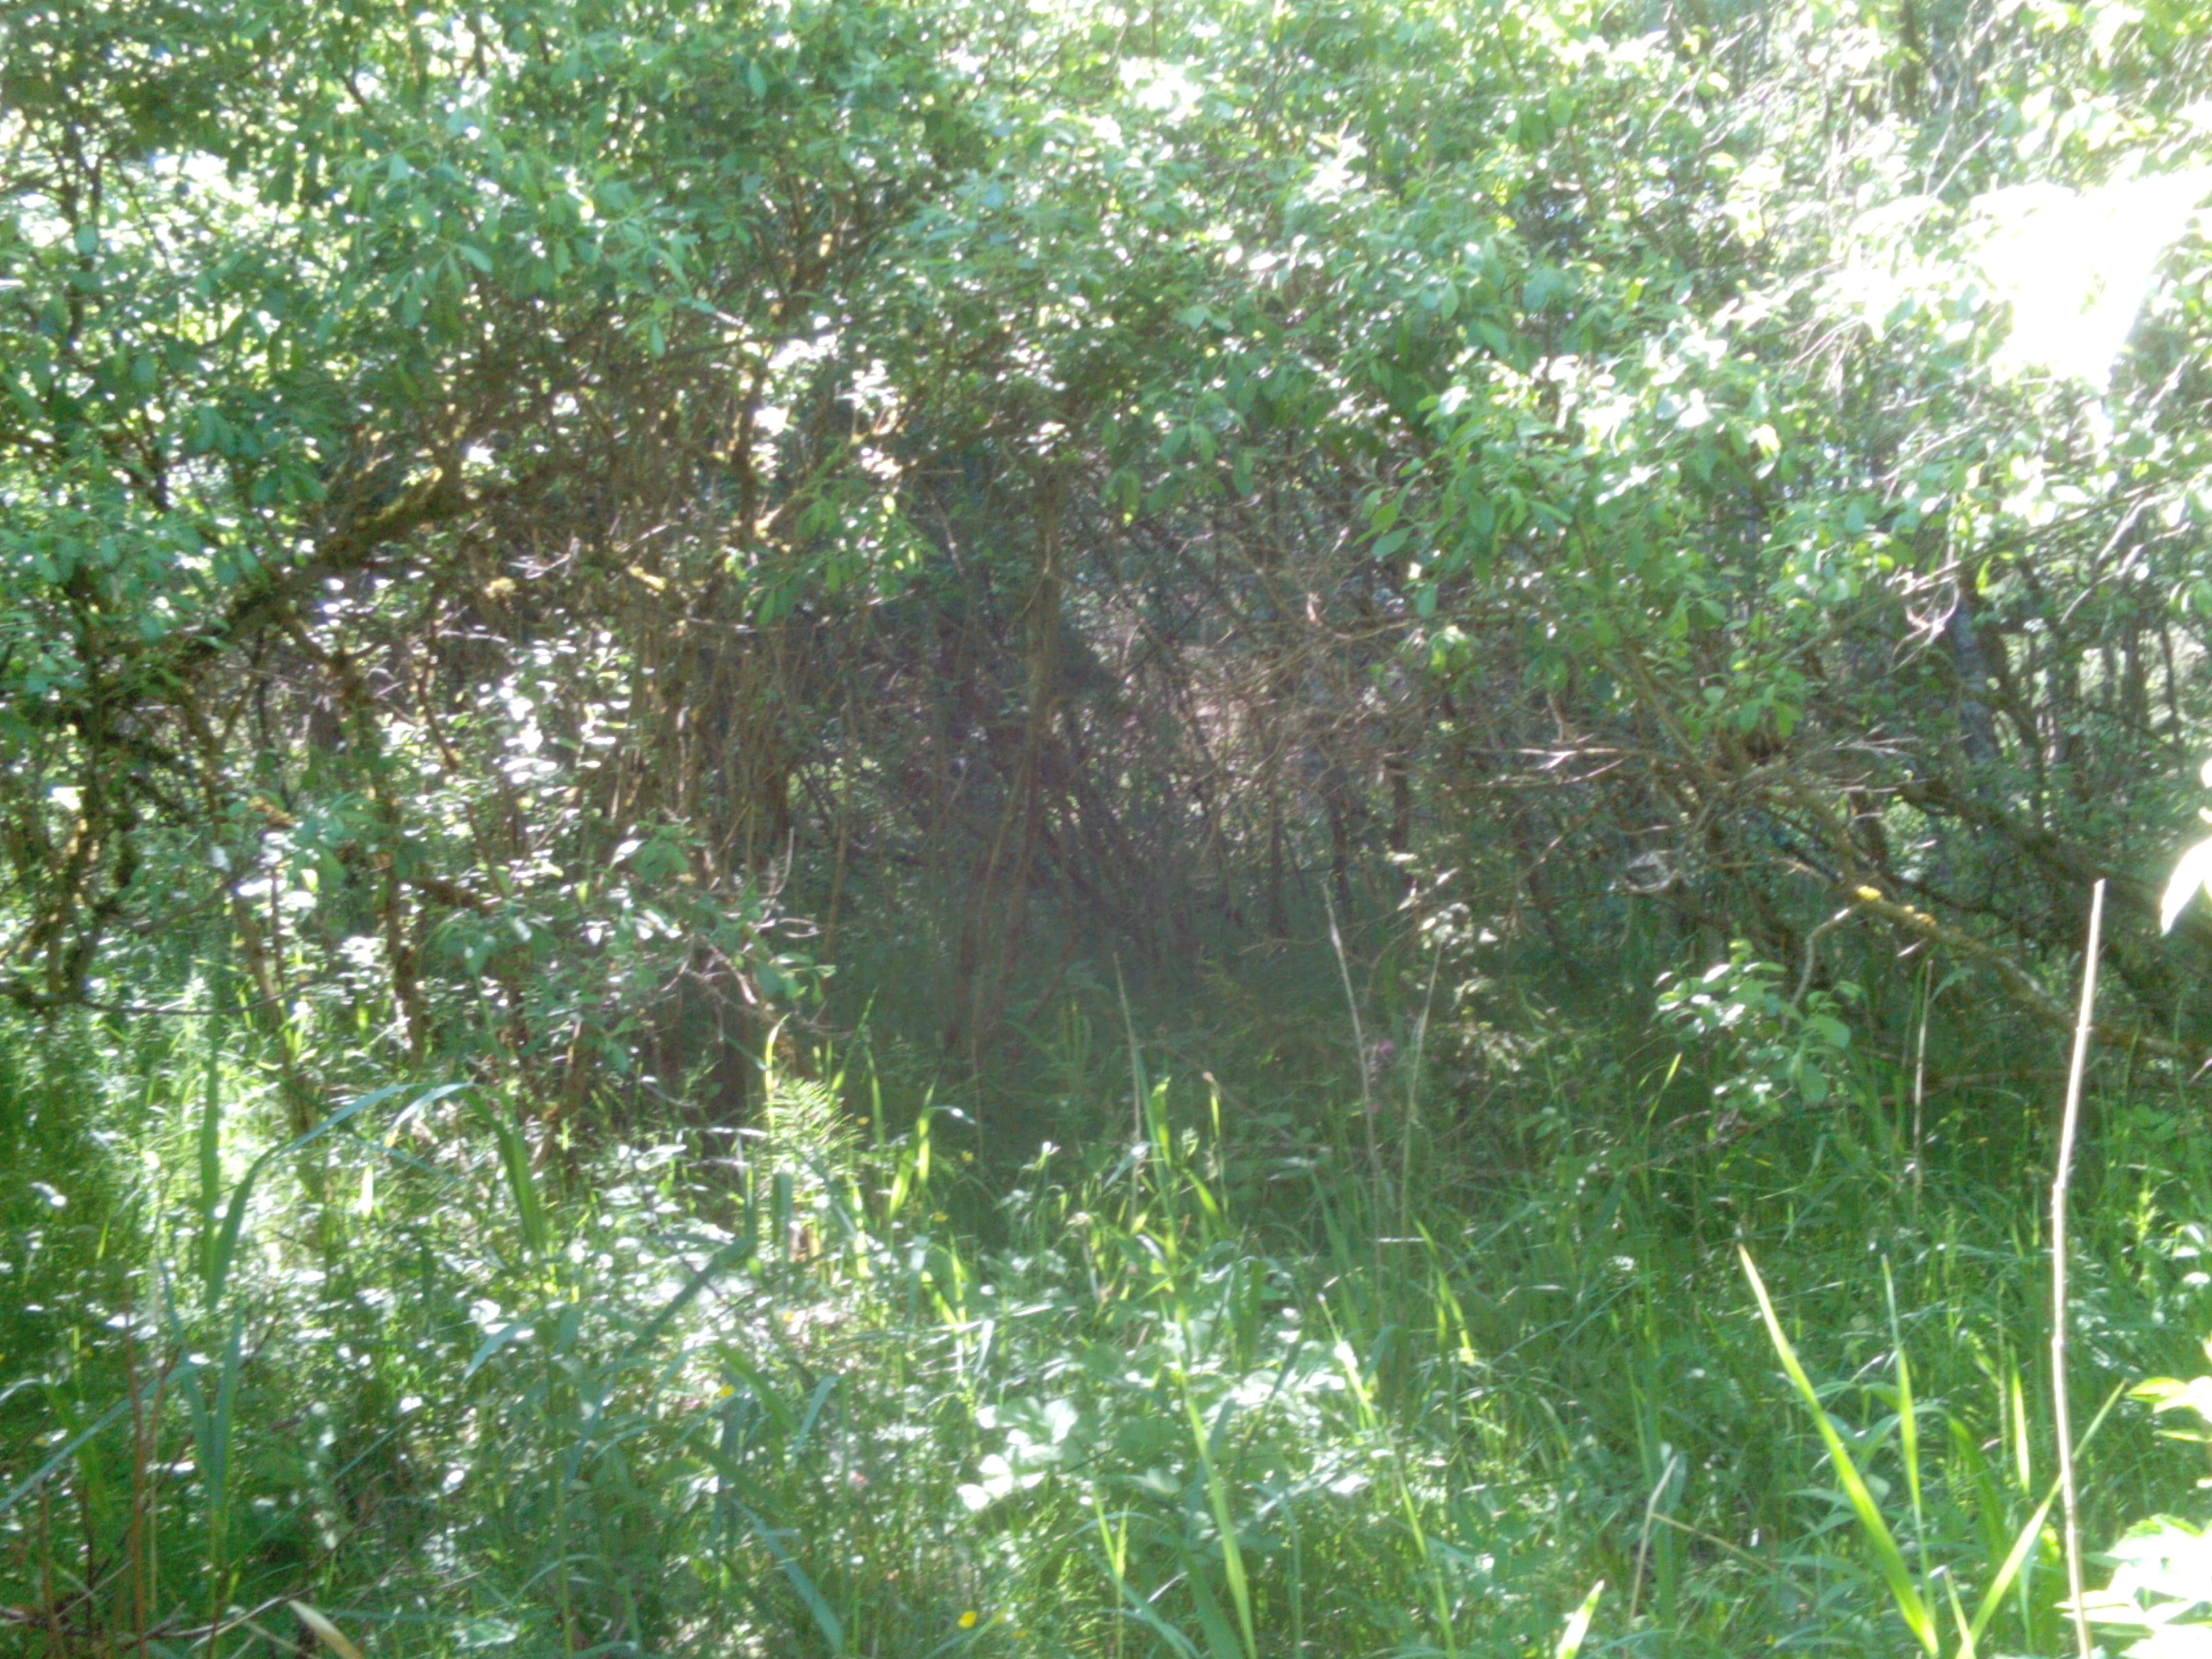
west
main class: Woodland
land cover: Spruce dominated mixed woodland
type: hemiboreal forest and nemoral coniferous forest and mixed broadleaved-coniferous forest
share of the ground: > 75 %
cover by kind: broadleaved forest trees 55 %, coniferous forest trees 25 %, shrubs 10 %, herbaceous plants 10 %
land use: Forestry
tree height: > 5 m
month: June
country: LV
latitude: 56.5940
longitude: 22.1185
